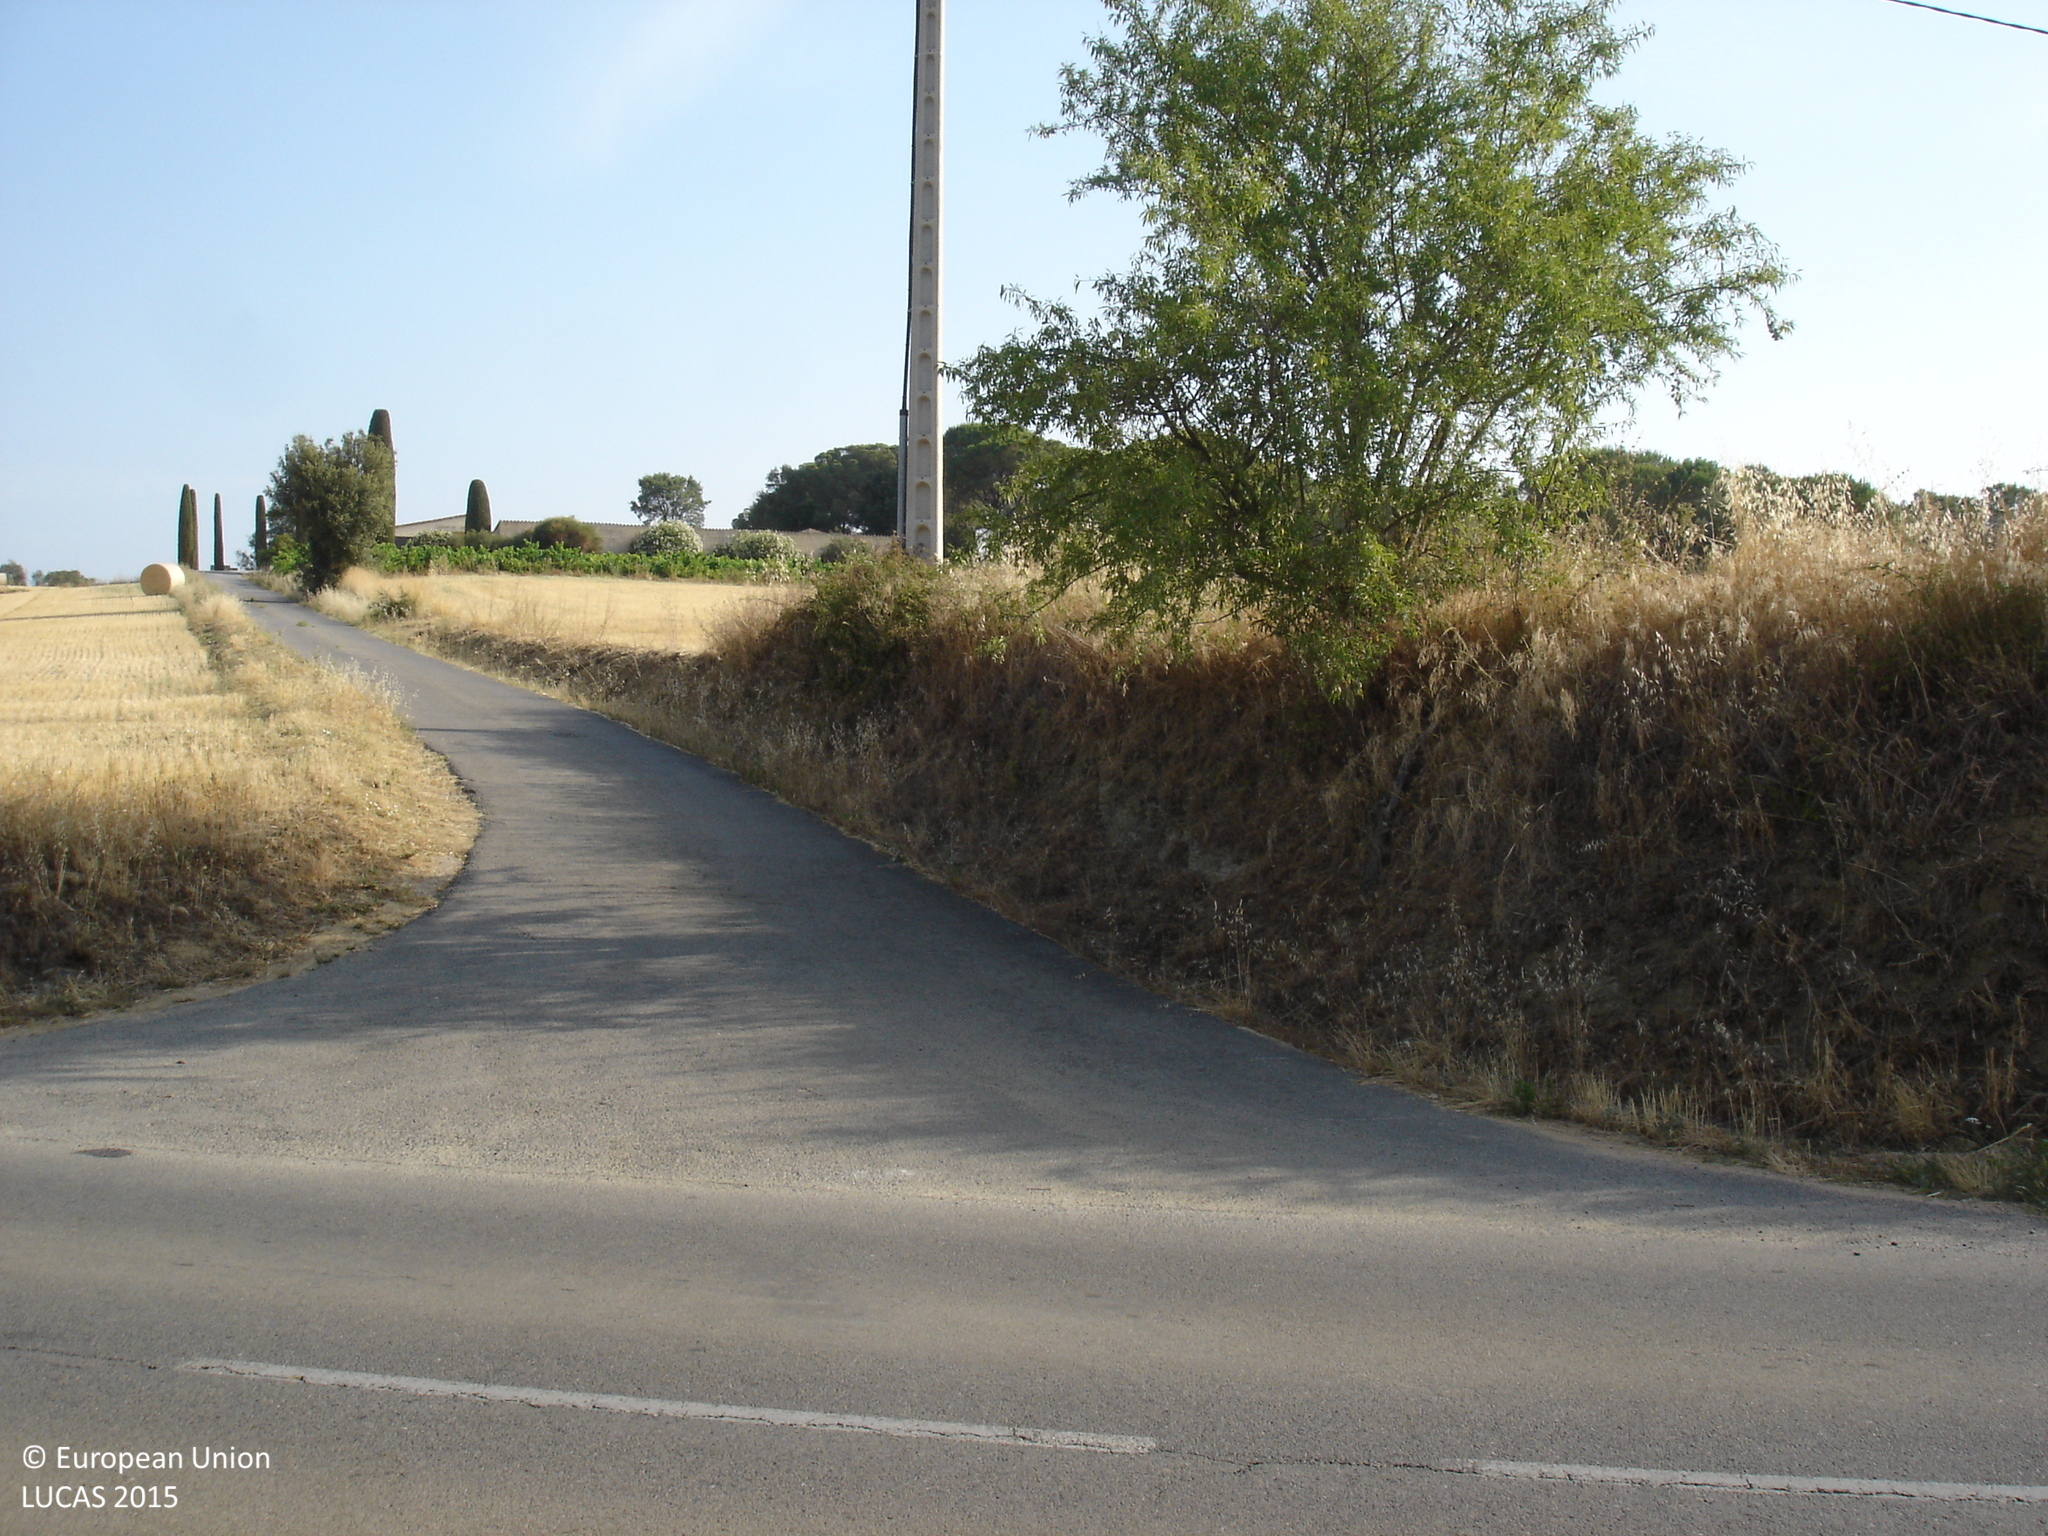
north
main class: Cropland
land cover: Olive groves
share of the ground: 25 - 50 %
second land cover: Other bare soil
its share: > 75 %
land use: Agriculture (excluding fallow land and kitchen gardens)
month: July
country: ES
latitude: 41.9590
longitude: 3.0061
